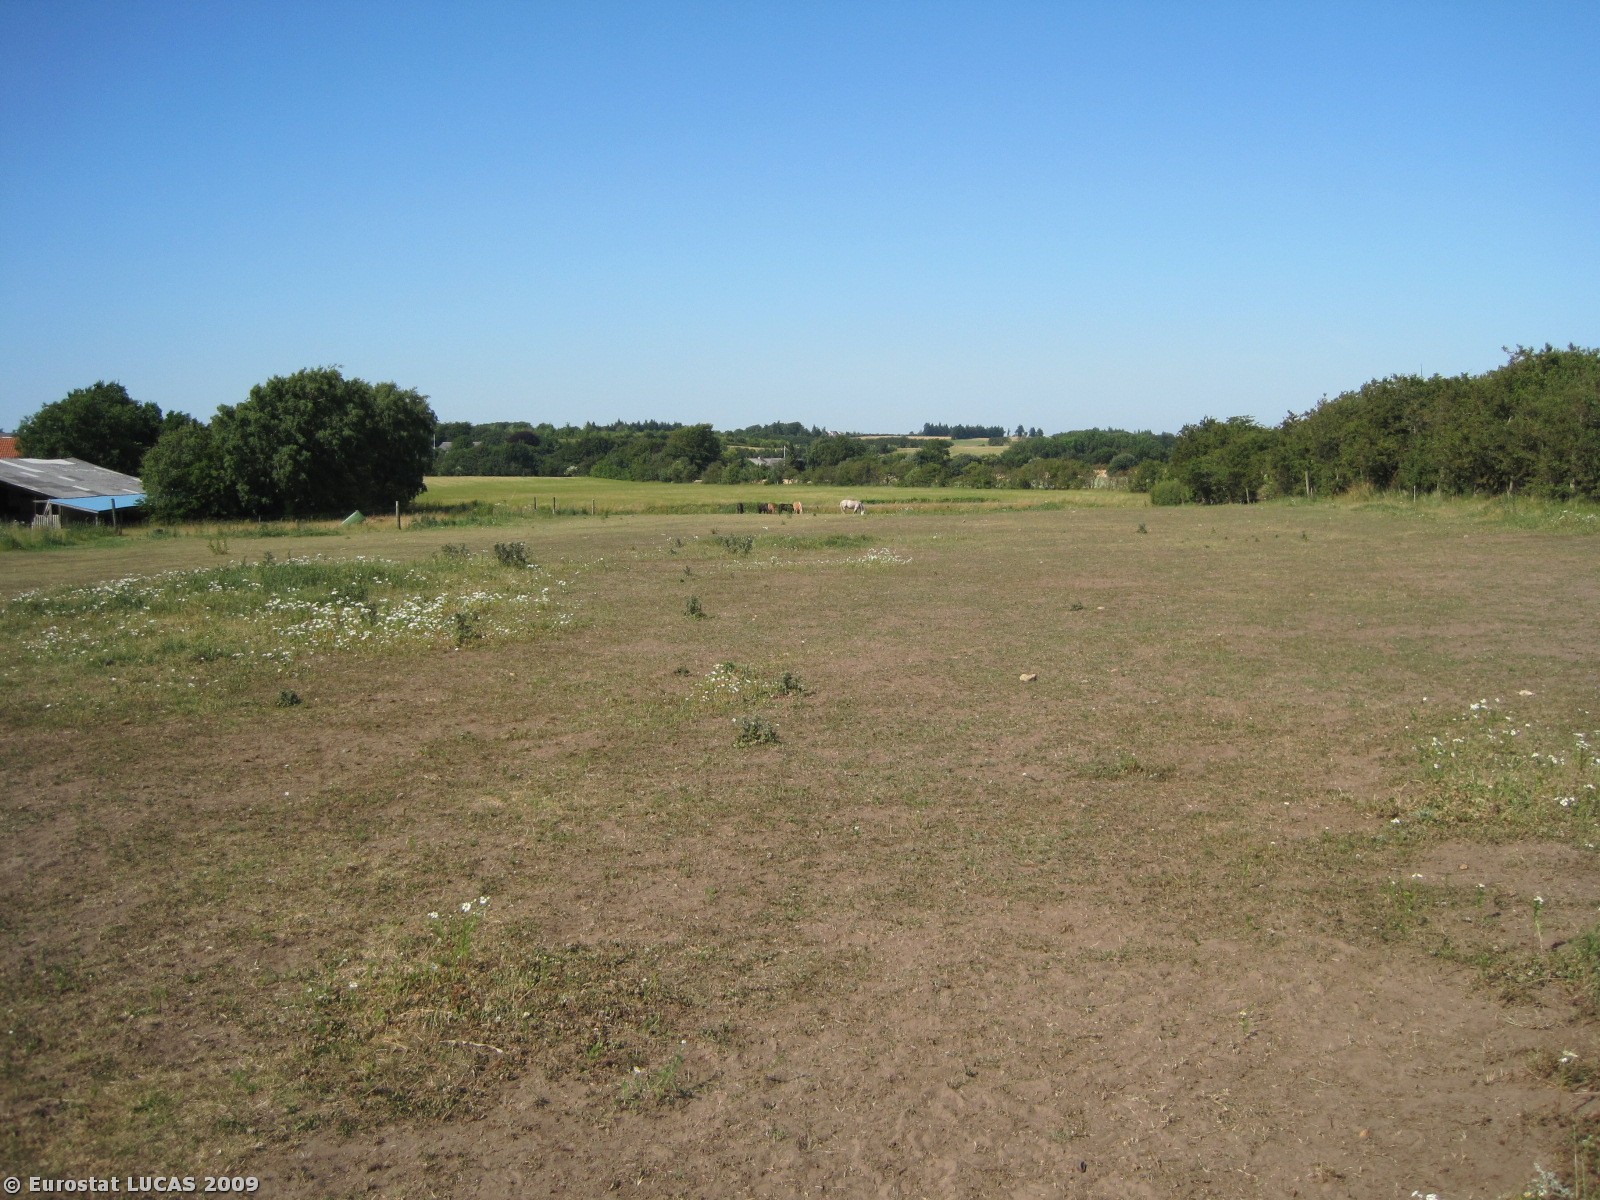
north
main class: Grassland
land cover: Grassland without tree/shrub cover
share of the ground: > 75 %
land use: Agriculture (excluding fallow land and kitchen gardens)
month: July
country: DK
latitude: 56.4127
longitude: 8.4945
